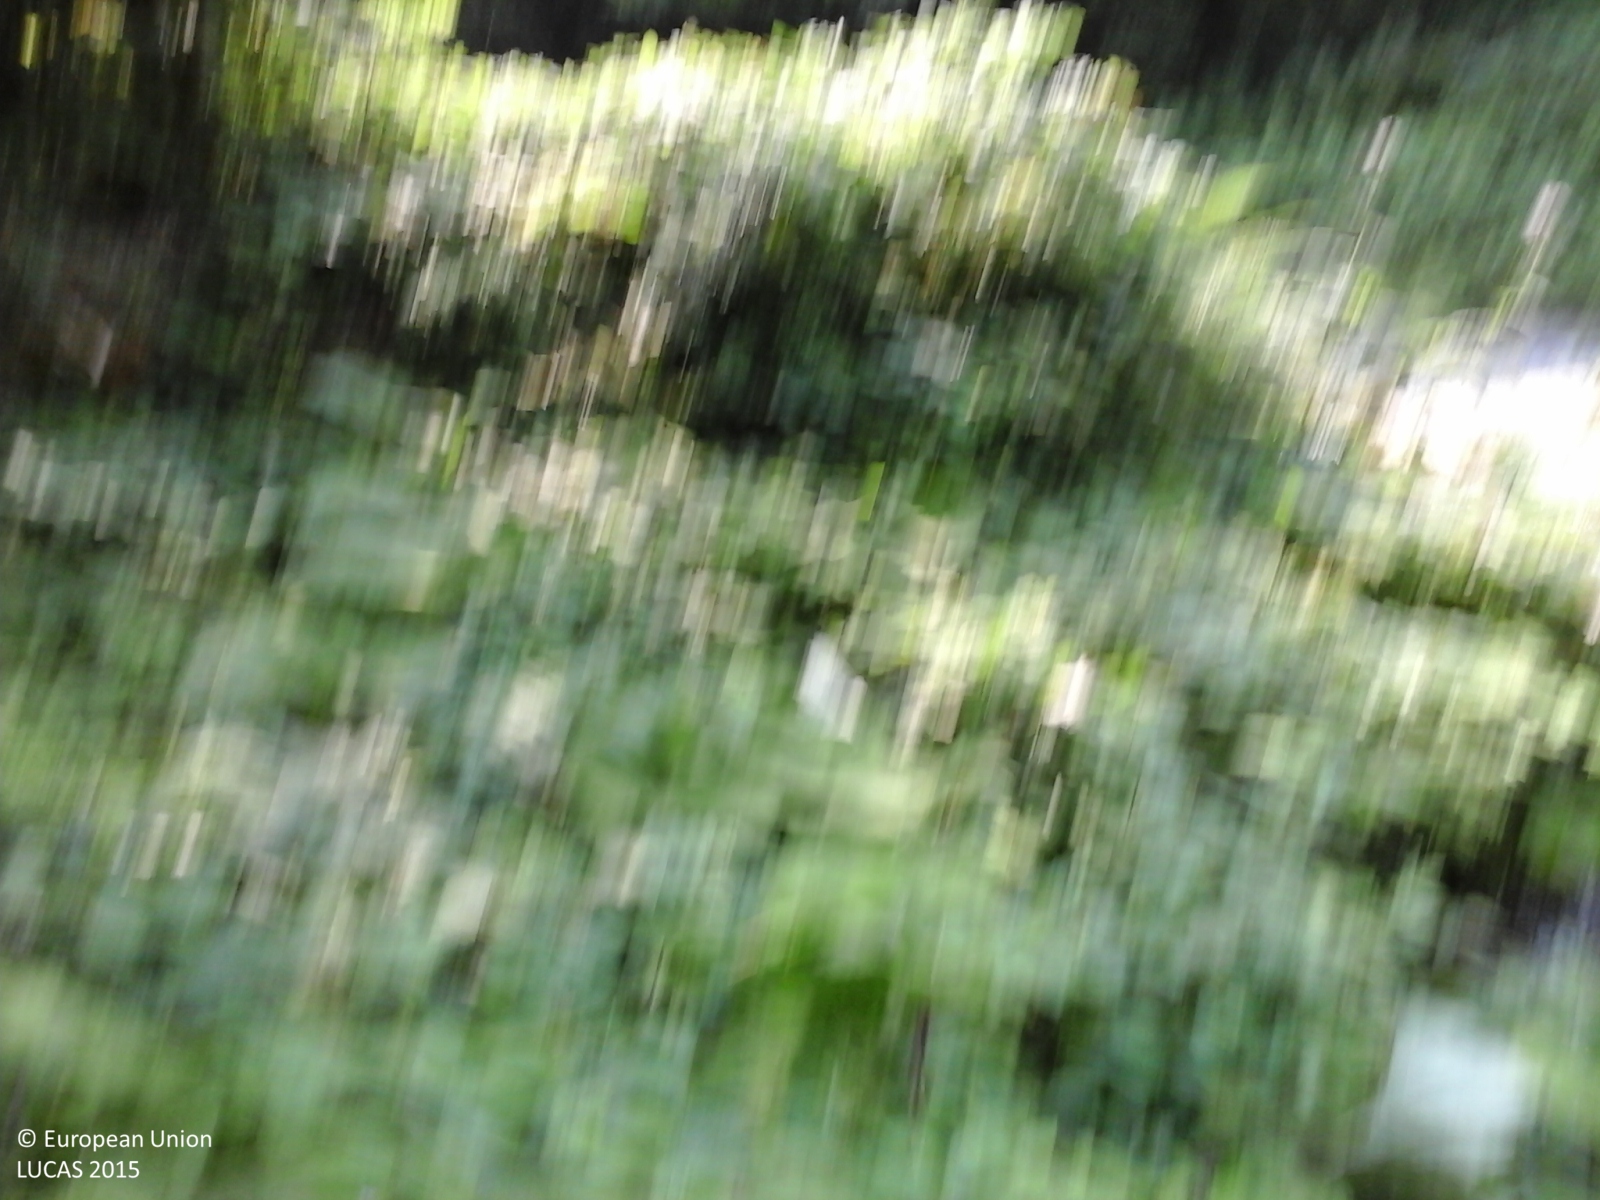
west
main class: Woodland
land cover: Broadleaved woodland
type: mountainous beech forest
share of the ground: > 75 %
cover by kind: broadleaved forest trees 100 %
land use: Forestry
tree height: > 5 m
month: July
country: IT
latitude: 44.4045
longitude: 7.2557
